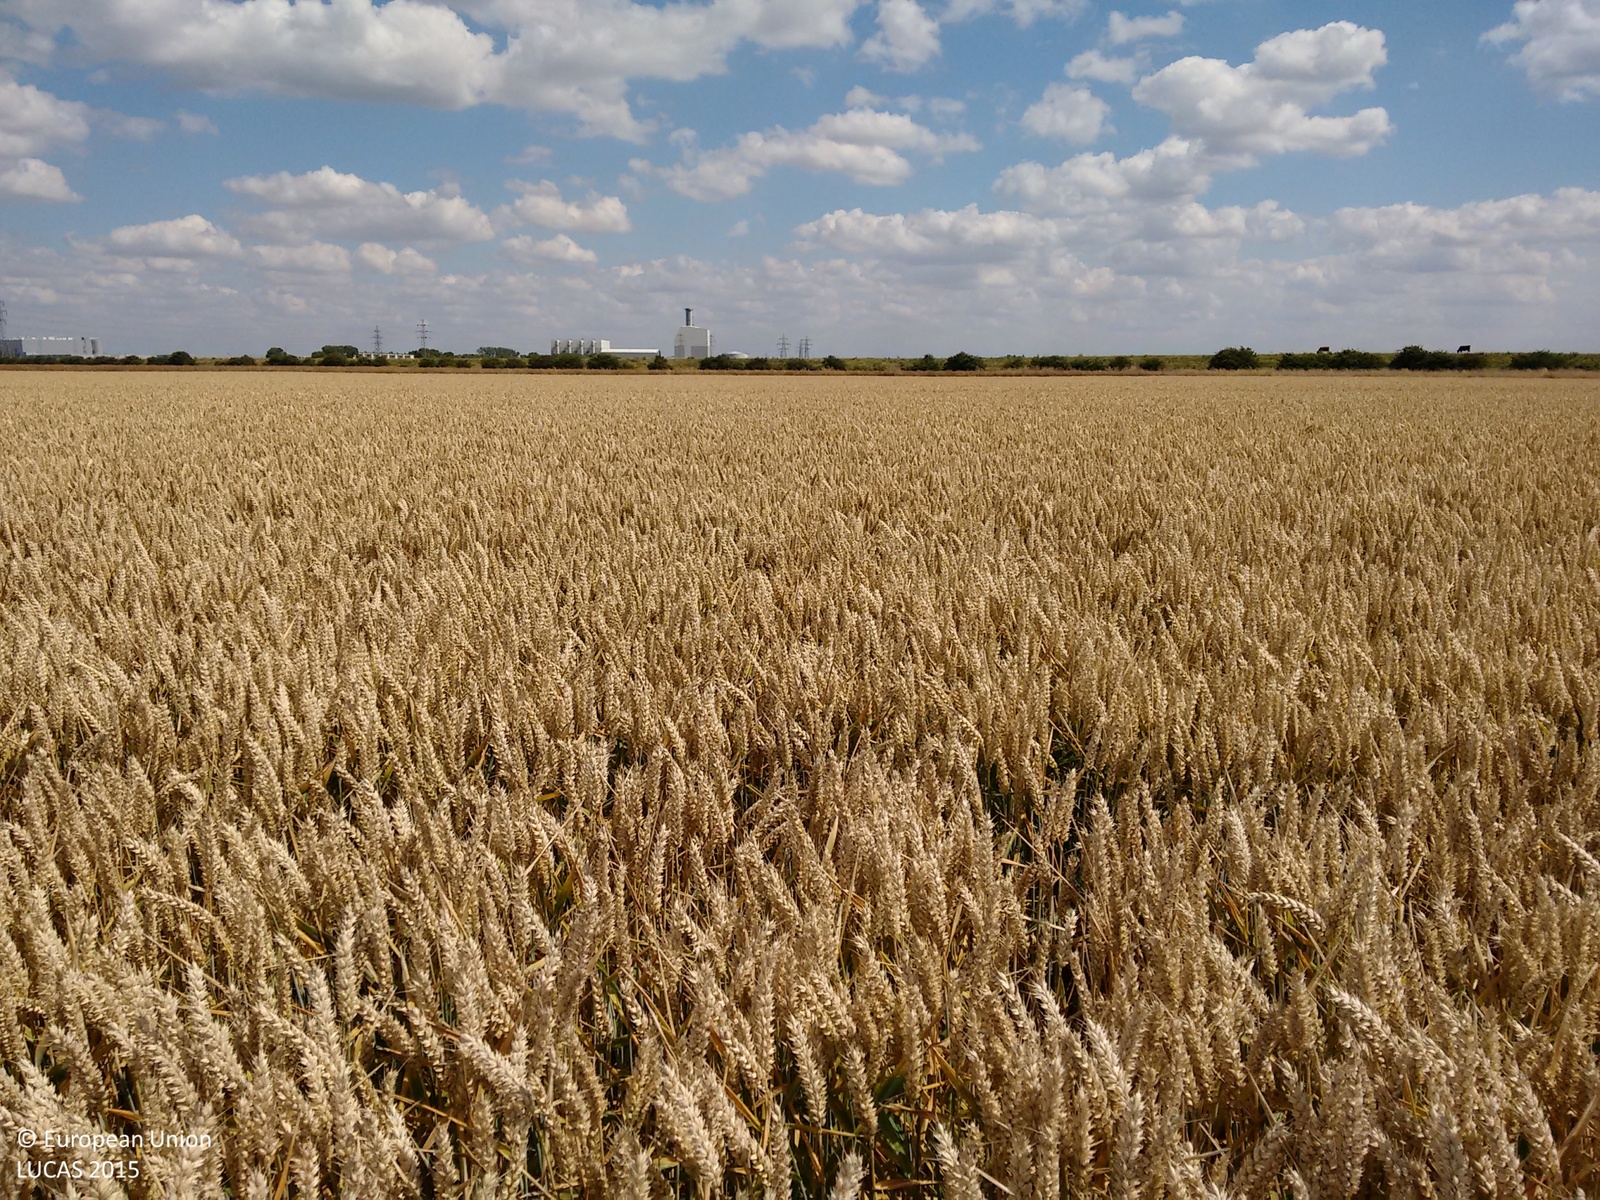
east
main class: Cropland
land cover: Common wheat
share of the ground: > 75 %
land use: Agriculture (excluding fallow land and kitchen gardens)
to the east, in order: Common wheat; Rape and turnip rape; Grass margins; Tracks; Grass margins; Ditches and canals; Fences; Abandoned hedges; Grassland without tree/shrub cover
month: July
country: GB
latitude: 52.7269
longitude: 0.3614
